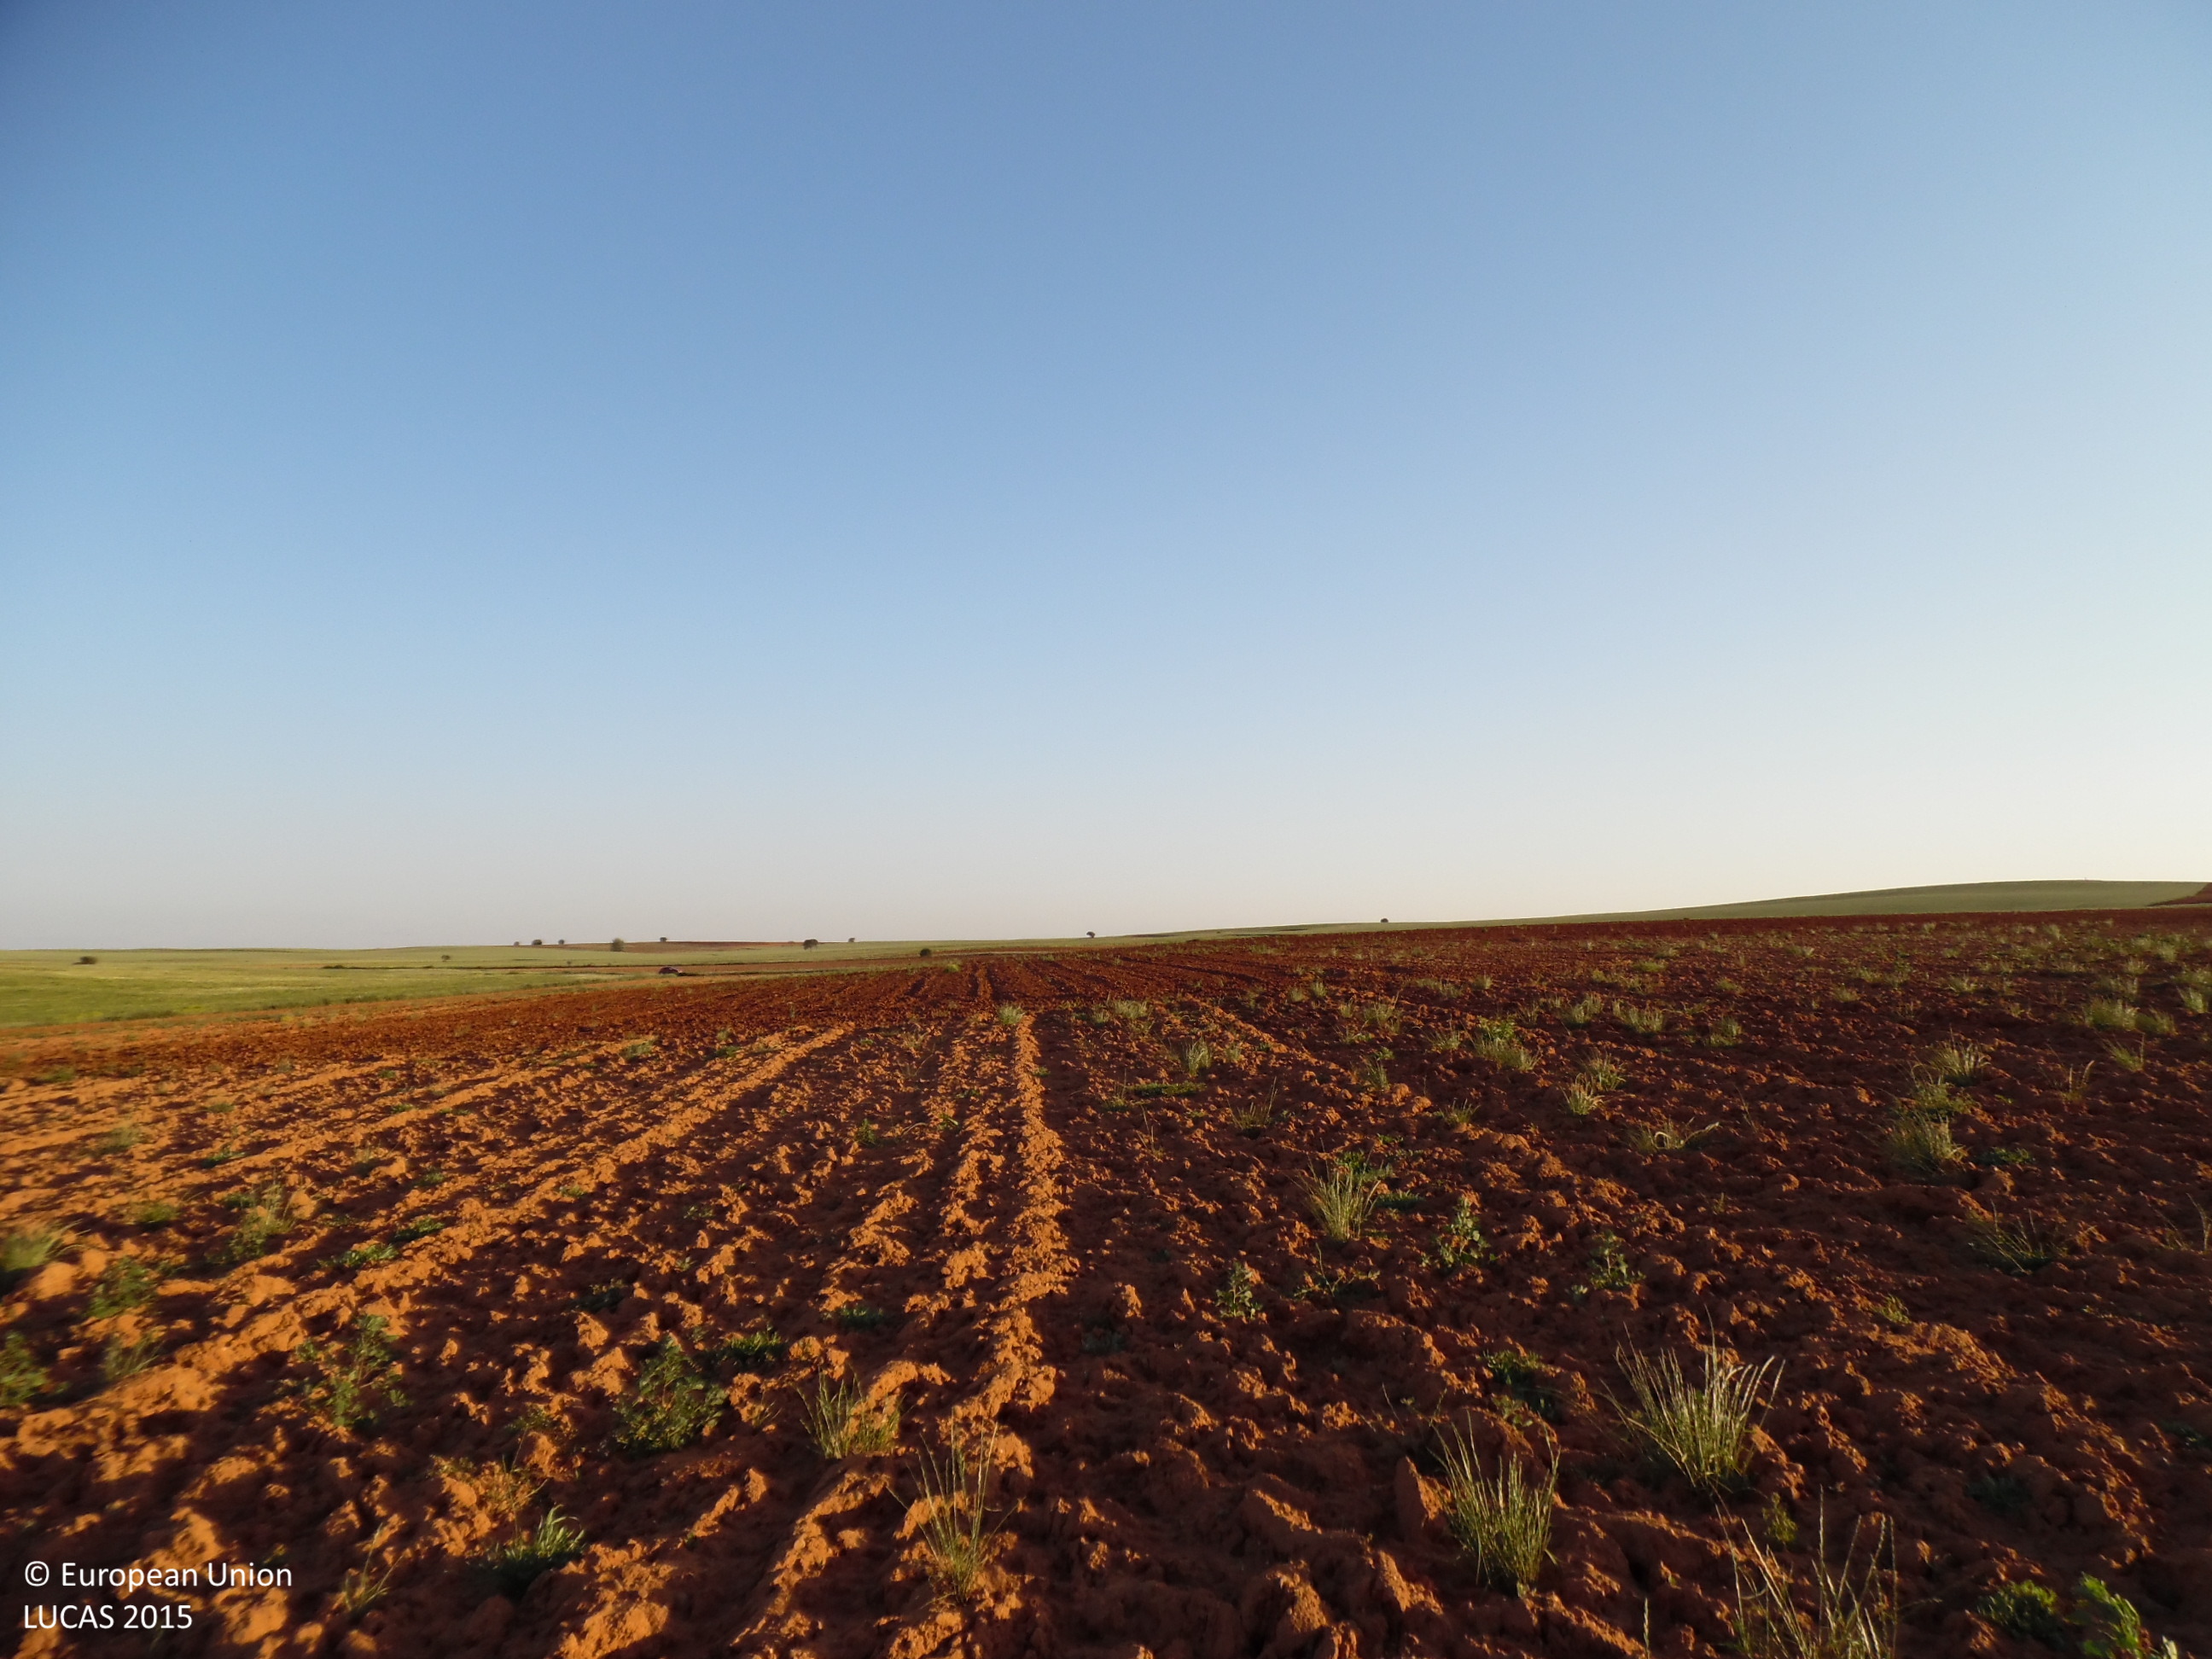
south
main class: Grassland
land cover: Spontaneously vegetated surfaces
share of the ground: 10 - 25 %
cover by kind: herbaceous plants 50 %, unconsolidated bare surface 50 %
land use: Fallow land
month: May
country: ES
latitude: 42.1562
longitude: -5.6942
